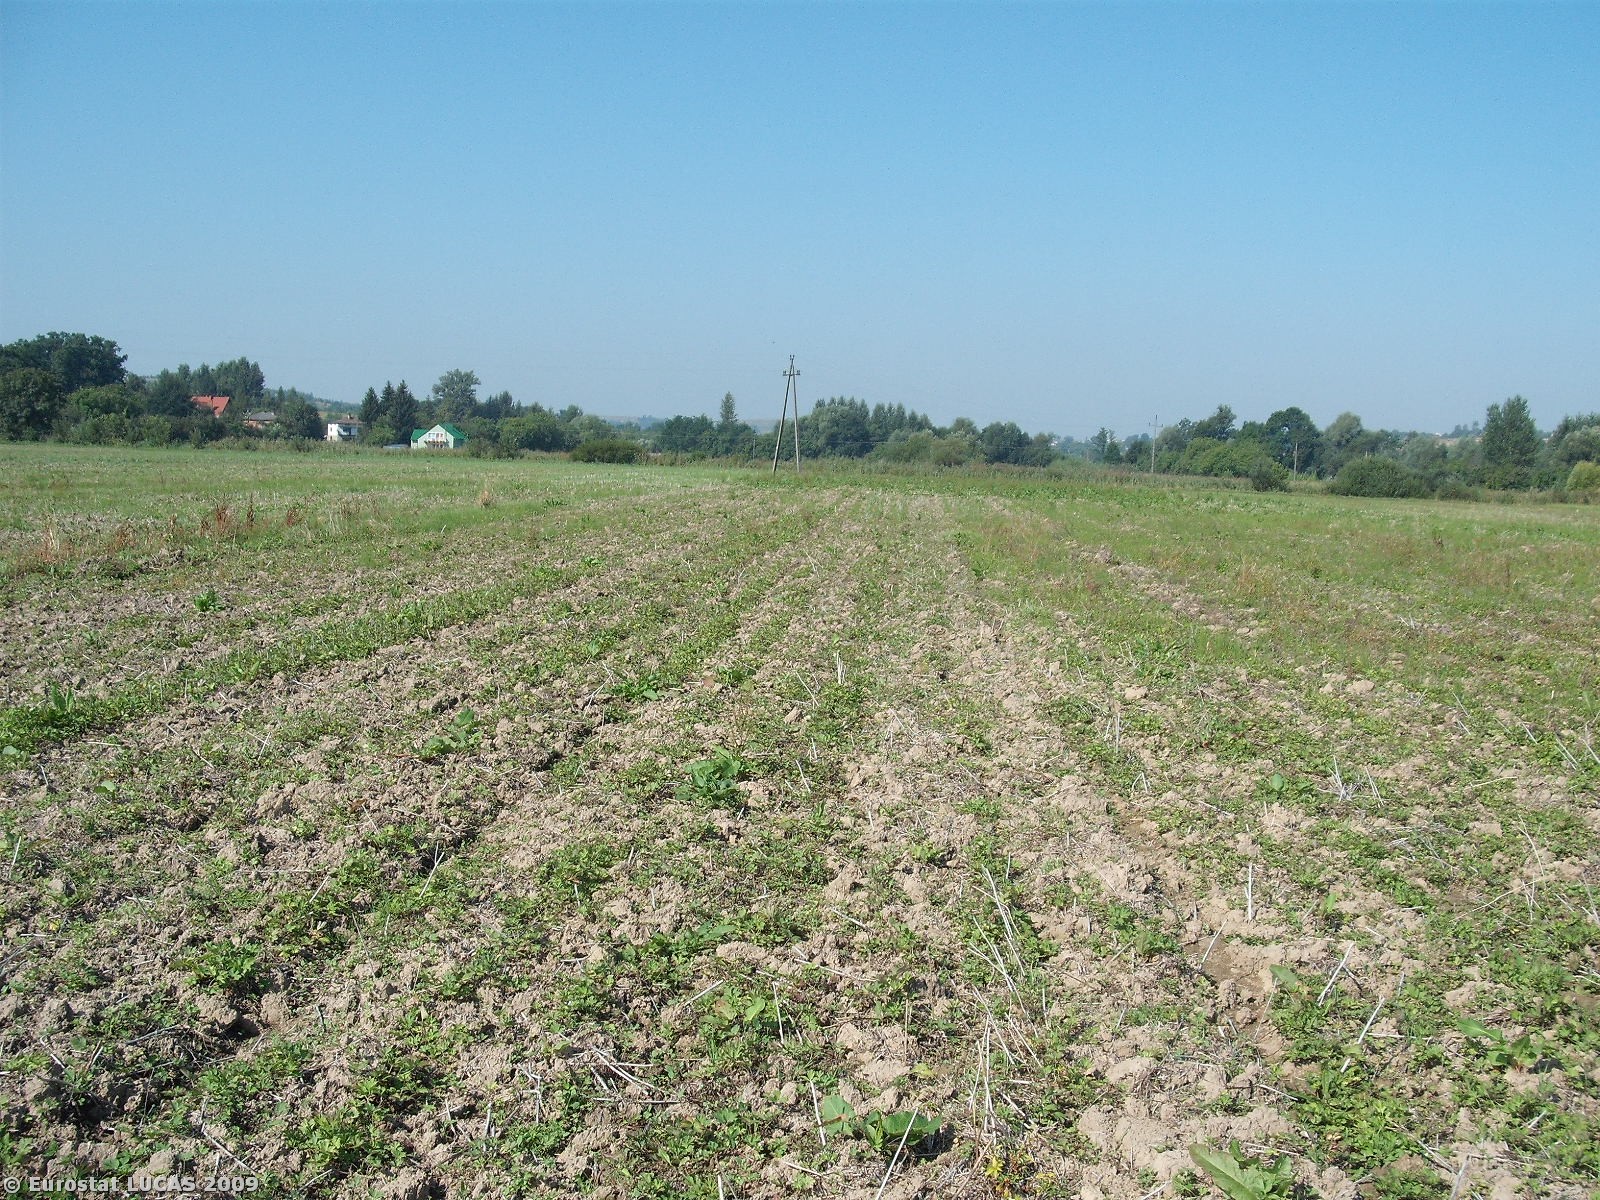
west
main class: Cropland
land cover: Rye
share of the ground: < 10 %
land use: Agriculture (excluding fallow land and kitchen gardens)
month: August
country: PL
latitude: 49.9055
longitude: 22.5556
